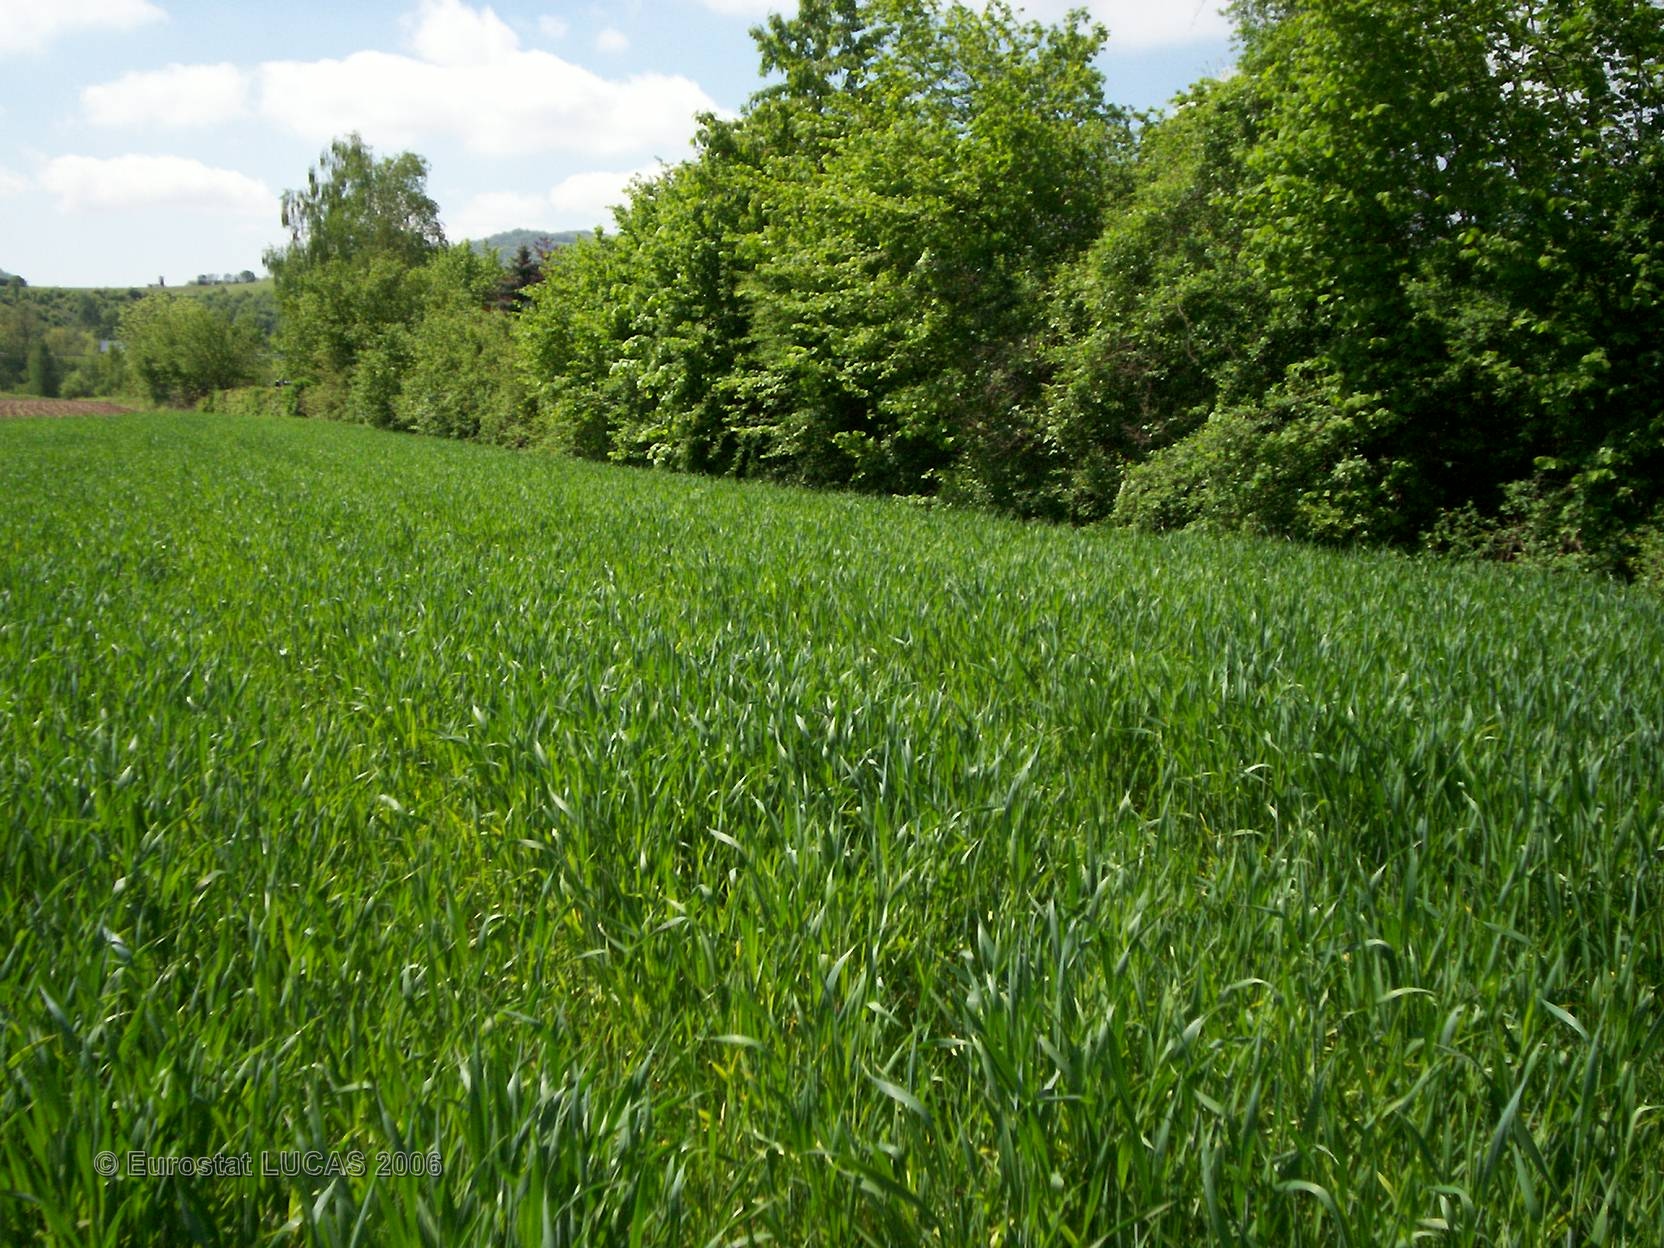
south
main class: Cropland
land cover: Common wheat
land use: Agriculture (excluding fallow land and kitchen gardens)
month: May
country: FR
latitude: 45.4409
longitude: 5.4152
